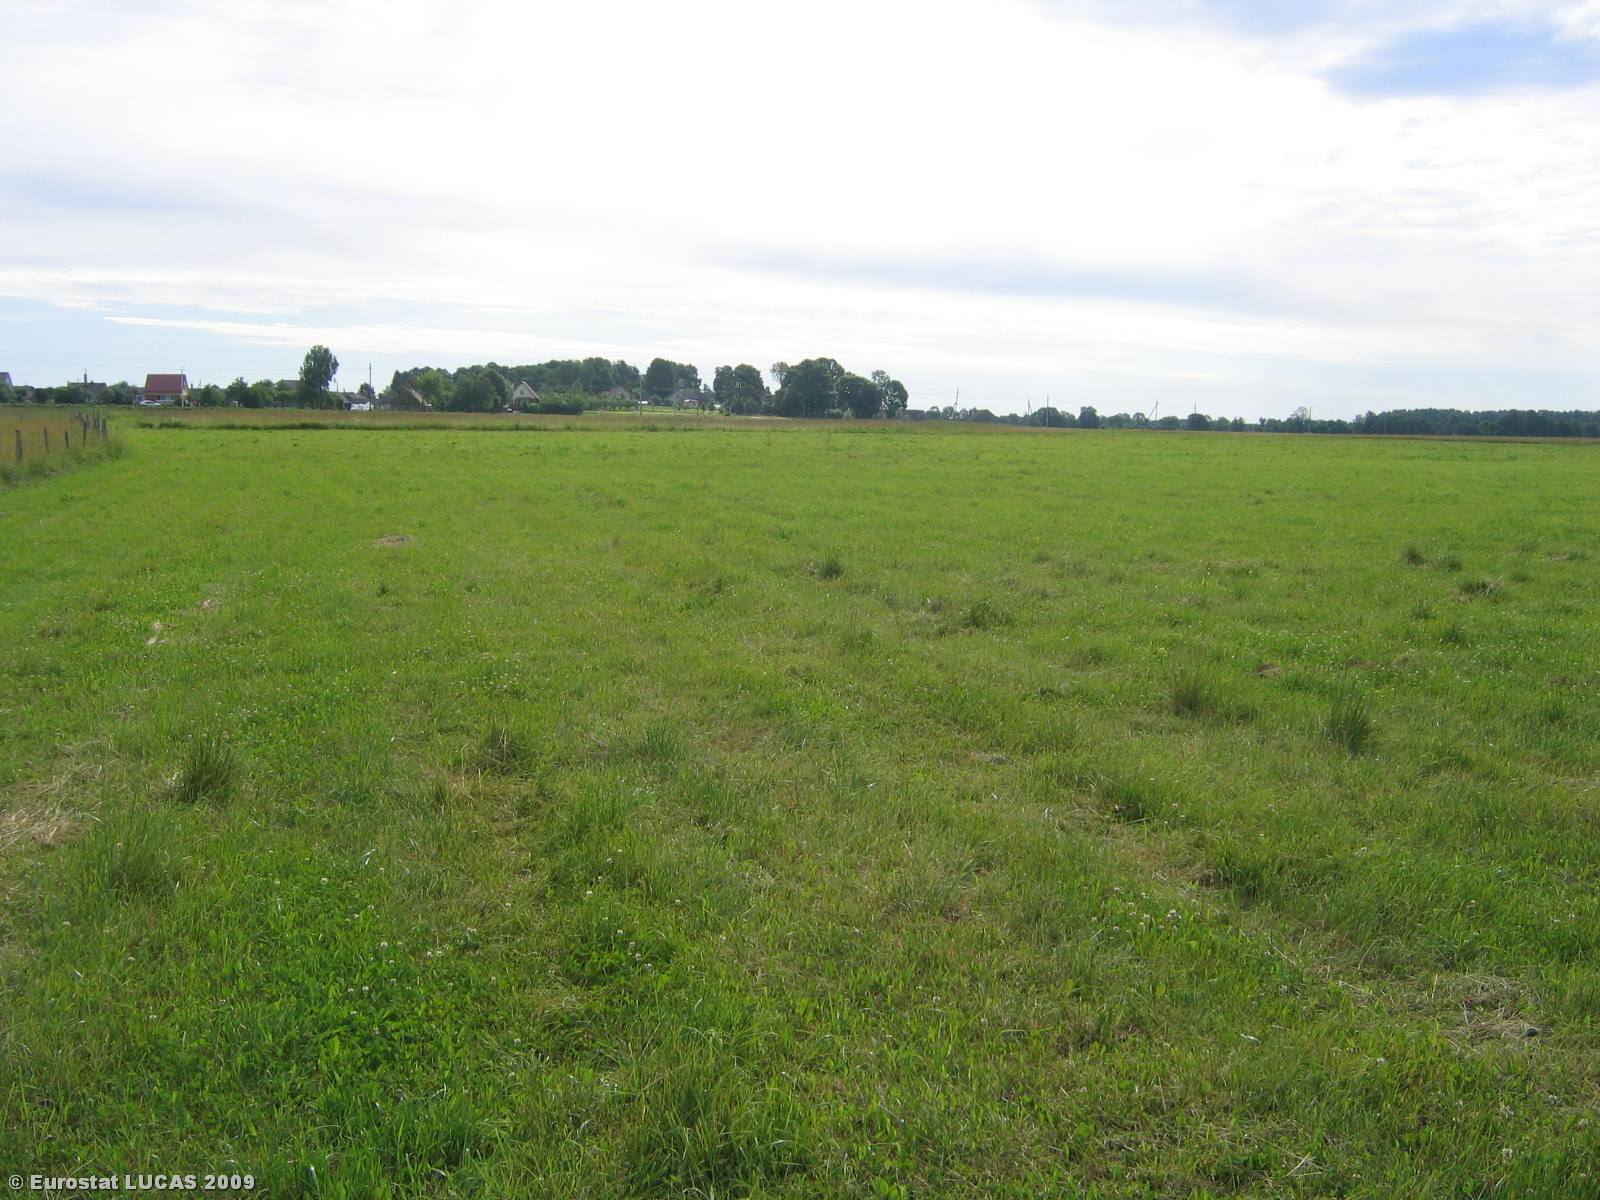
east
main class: Grassland
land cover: Grassland without tree/shrub cover
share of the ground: > 75 %
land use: Agriculture (excluding fallow land and kitchen gardens)
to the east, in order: Grassland without tree/shrub cover; Rye; Grassland without tree/shrub cover
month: July
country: LT
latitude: 55.3387
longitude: 22.6615
